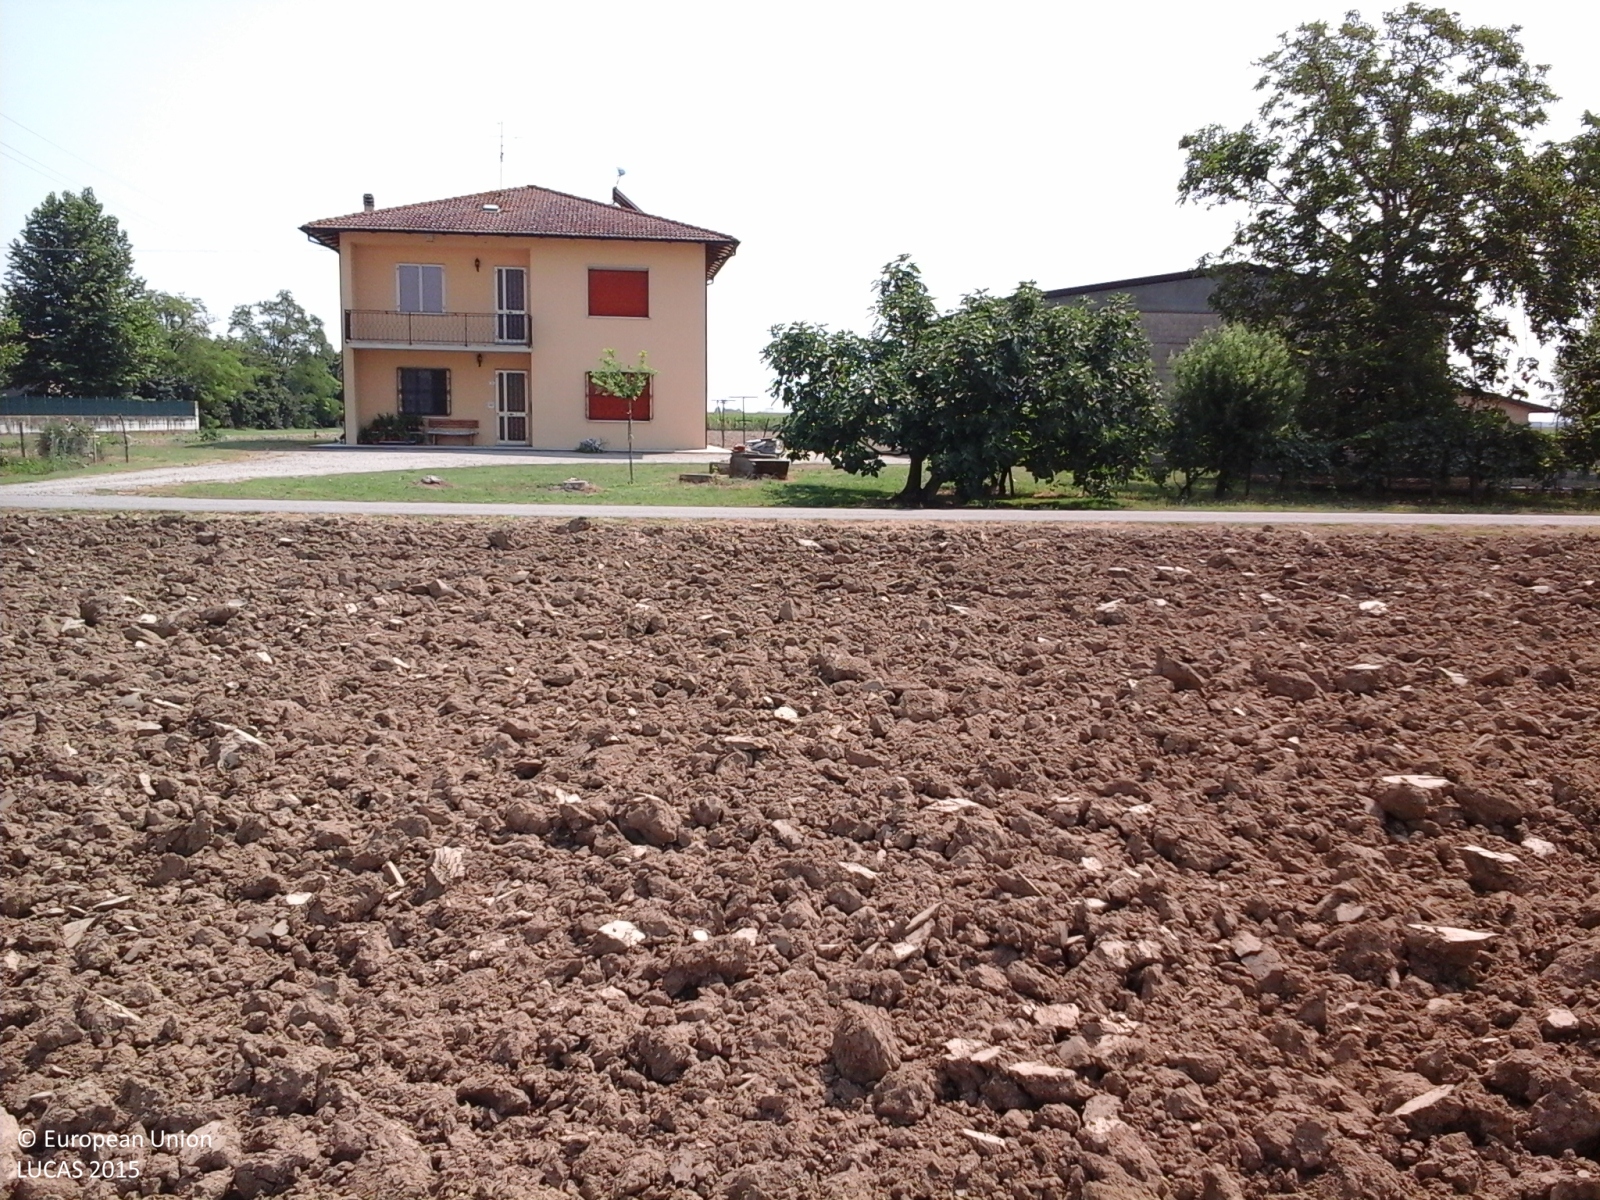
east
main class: Cropland
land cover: Durum wheat
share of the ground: < 10 %
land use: Agriculture (excluding fallow land and kitchen gardens)
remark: Harvested field
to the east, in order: Durum wheat; Grass margins; Artificial constructions in urban areas; Durum wheat
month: July
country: IT
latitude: 44.6084
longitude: 11.6220
